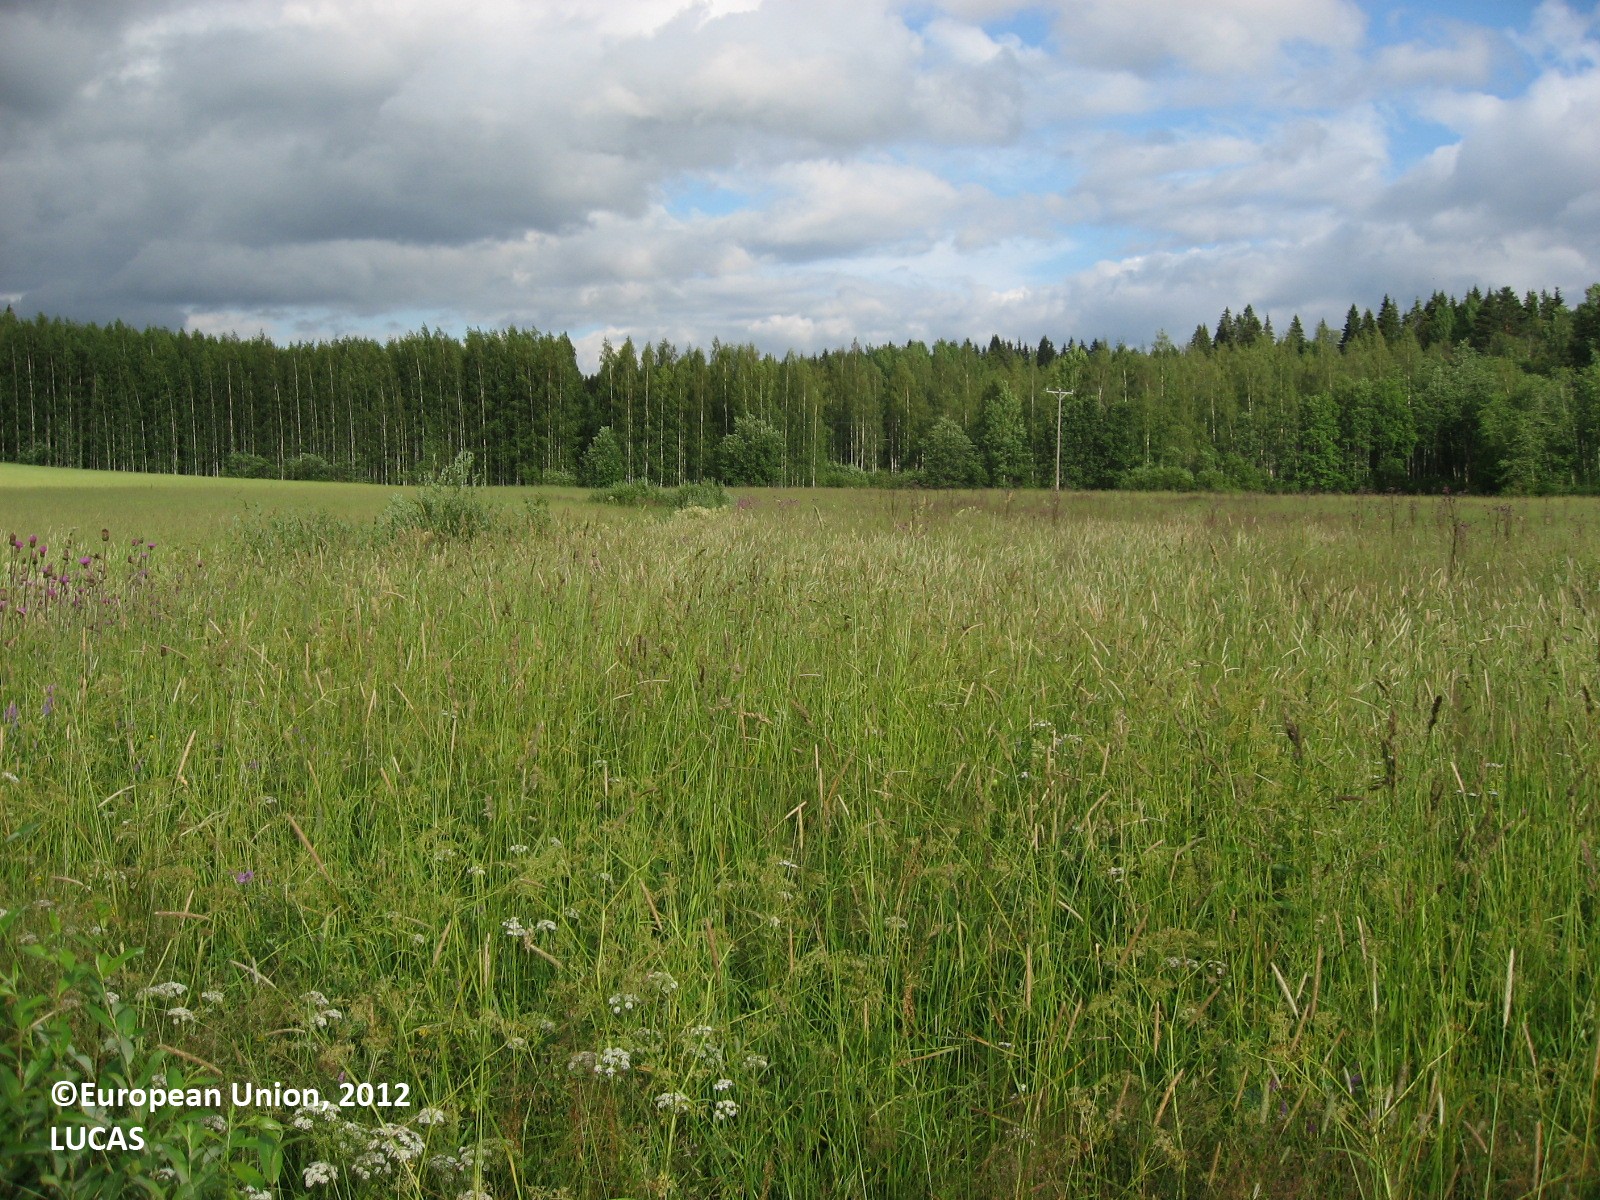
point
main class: Cropland
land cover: Temporary grasslands
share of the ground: > 75 %
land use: Agriculture (excluding fallow land and kitchen gardens)
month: July
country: FI
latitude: 61.0039
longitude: 25.7206
